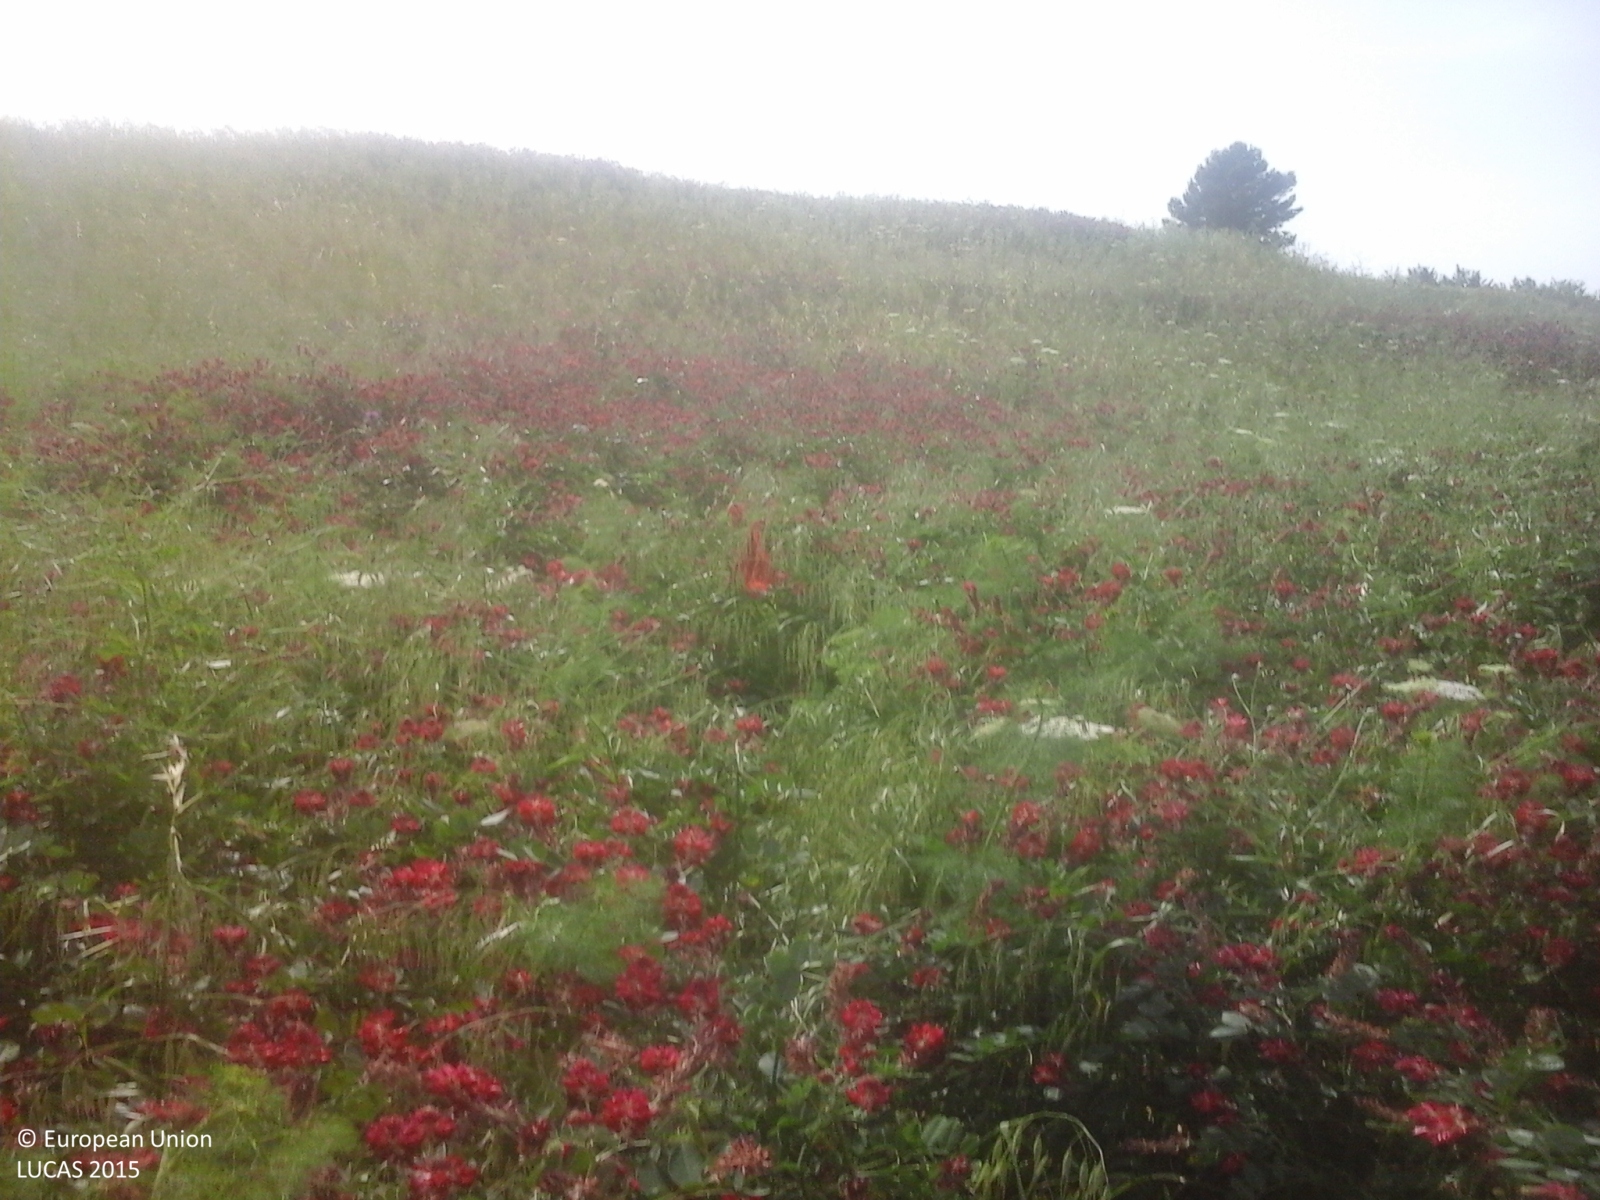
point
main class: Cropland
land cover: Temporary grasslands
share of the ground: > 75 %
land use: Agriculture (excluding fallow land and kitchen gardens)
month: May
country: IT
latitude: 37.5930
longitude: 13.9461
